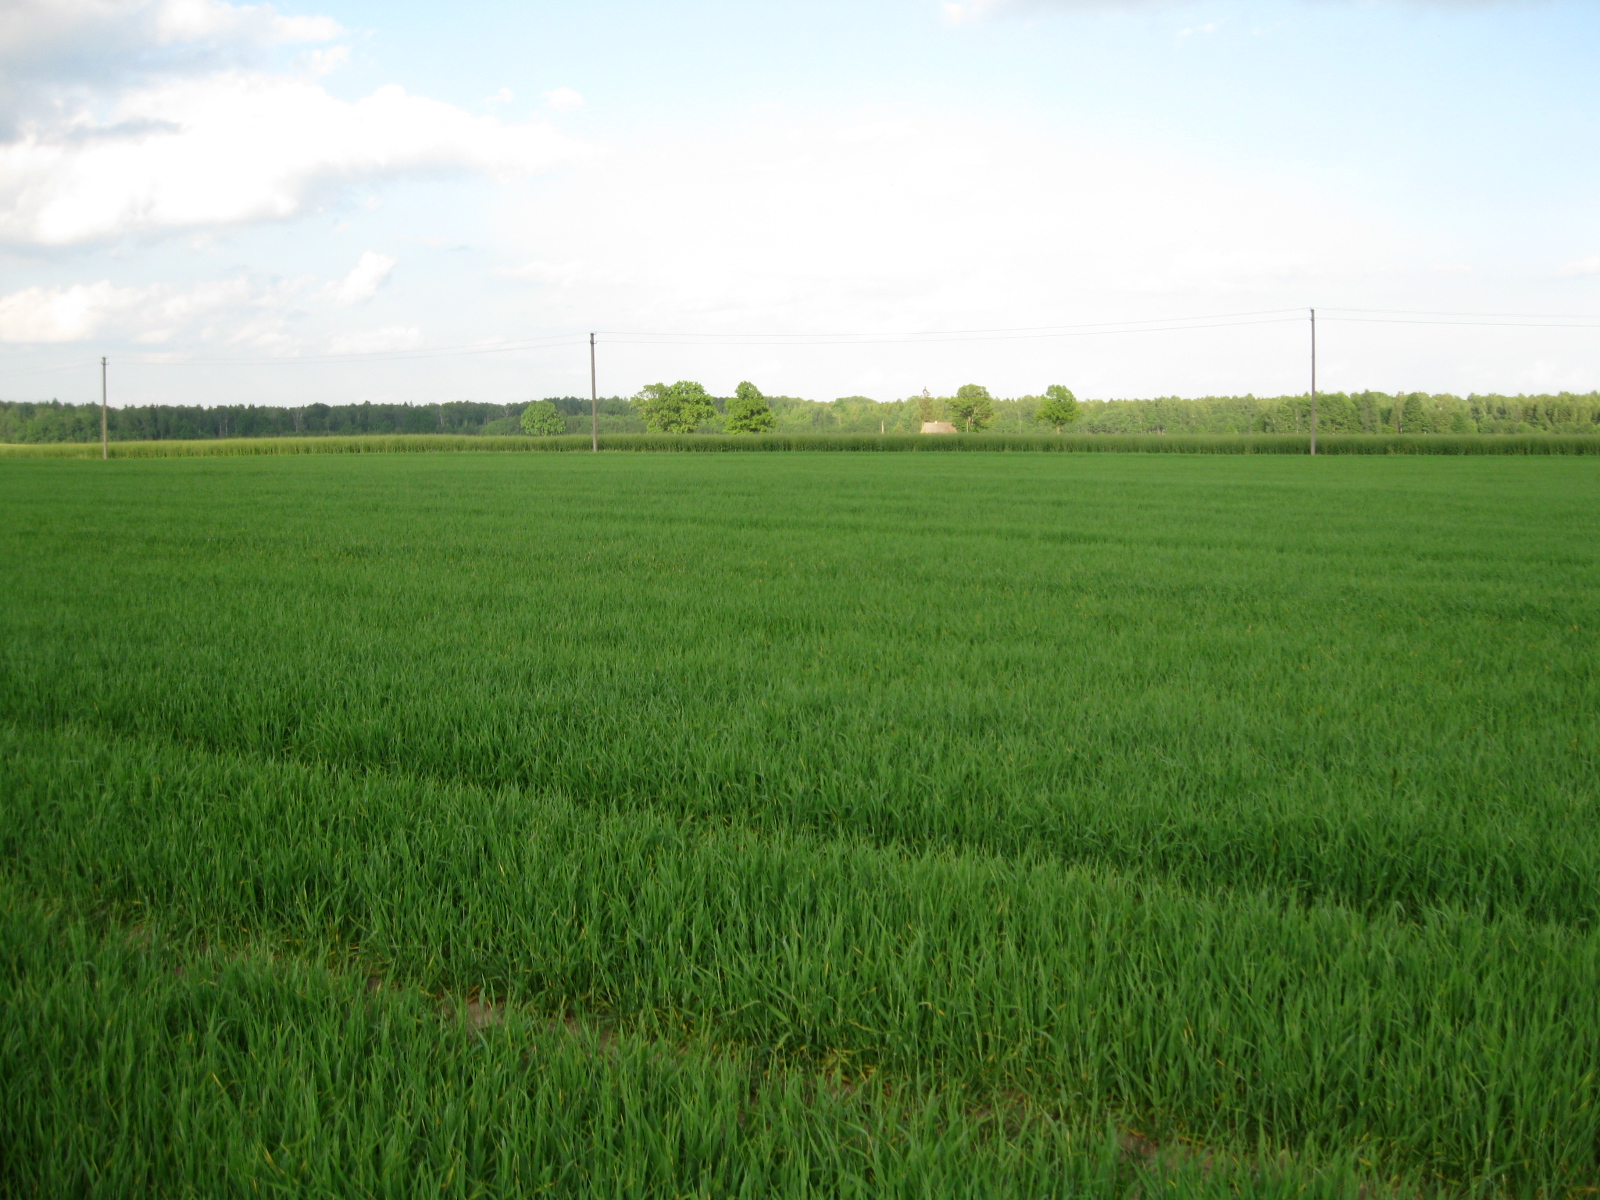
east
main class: Cropland
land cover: Barley
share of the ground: > 75 %
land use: Agriculture (excluding fallow land and kitchen gardens)
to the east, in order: Barley; Tracks; Grass margins; Electric lines; Rape and turnip rape
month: June
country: LT
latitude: 55.5753
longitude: 23.7075
